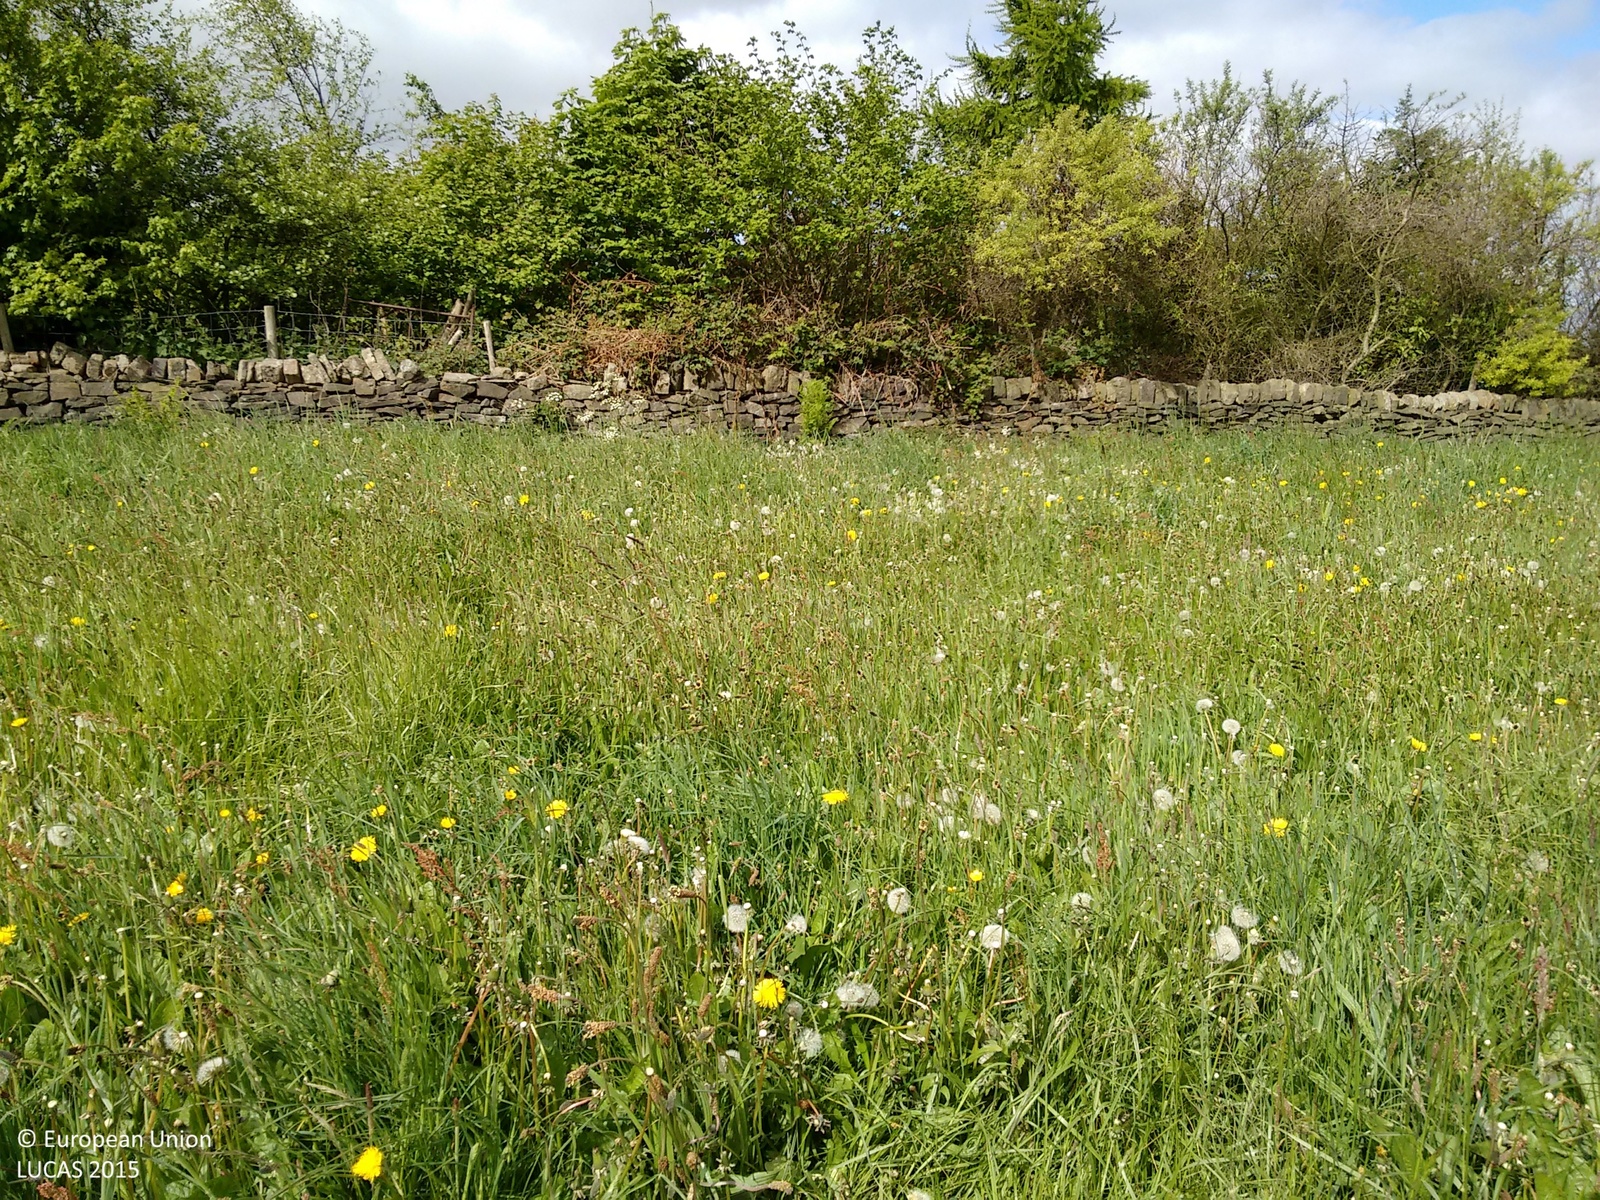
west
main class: Grassland
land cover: Grassland without tree/shrub cover
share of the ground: > 75 %
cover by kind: herbaceous plants 100 %
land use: Agriculture (excluding fallow land and kitchen gardens)
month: May
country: GB
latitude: 53.3918
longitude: -1.5544
